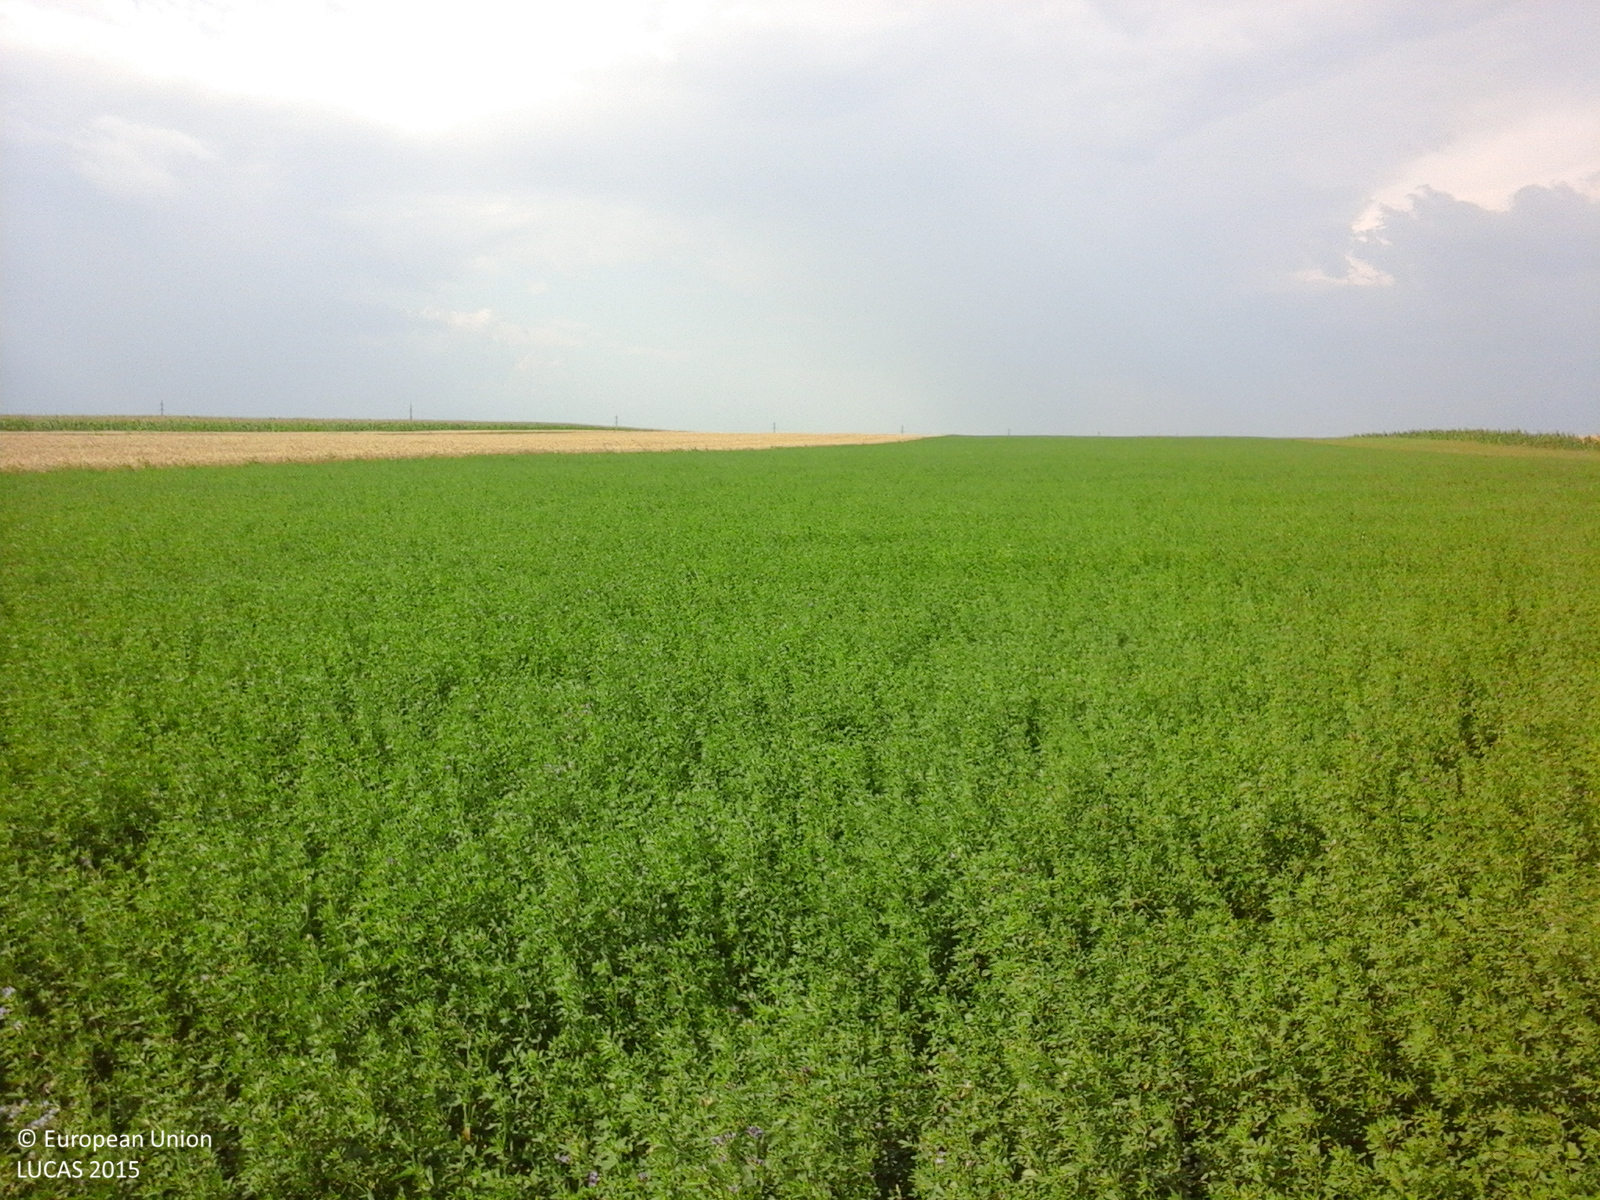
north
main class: Cropland
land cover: Lucerne
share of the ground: > 75 %
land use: Agriculture (excluding fallow land and kitchen gardens)
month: July
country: RO
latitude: 43.7700
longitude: 24.3353
